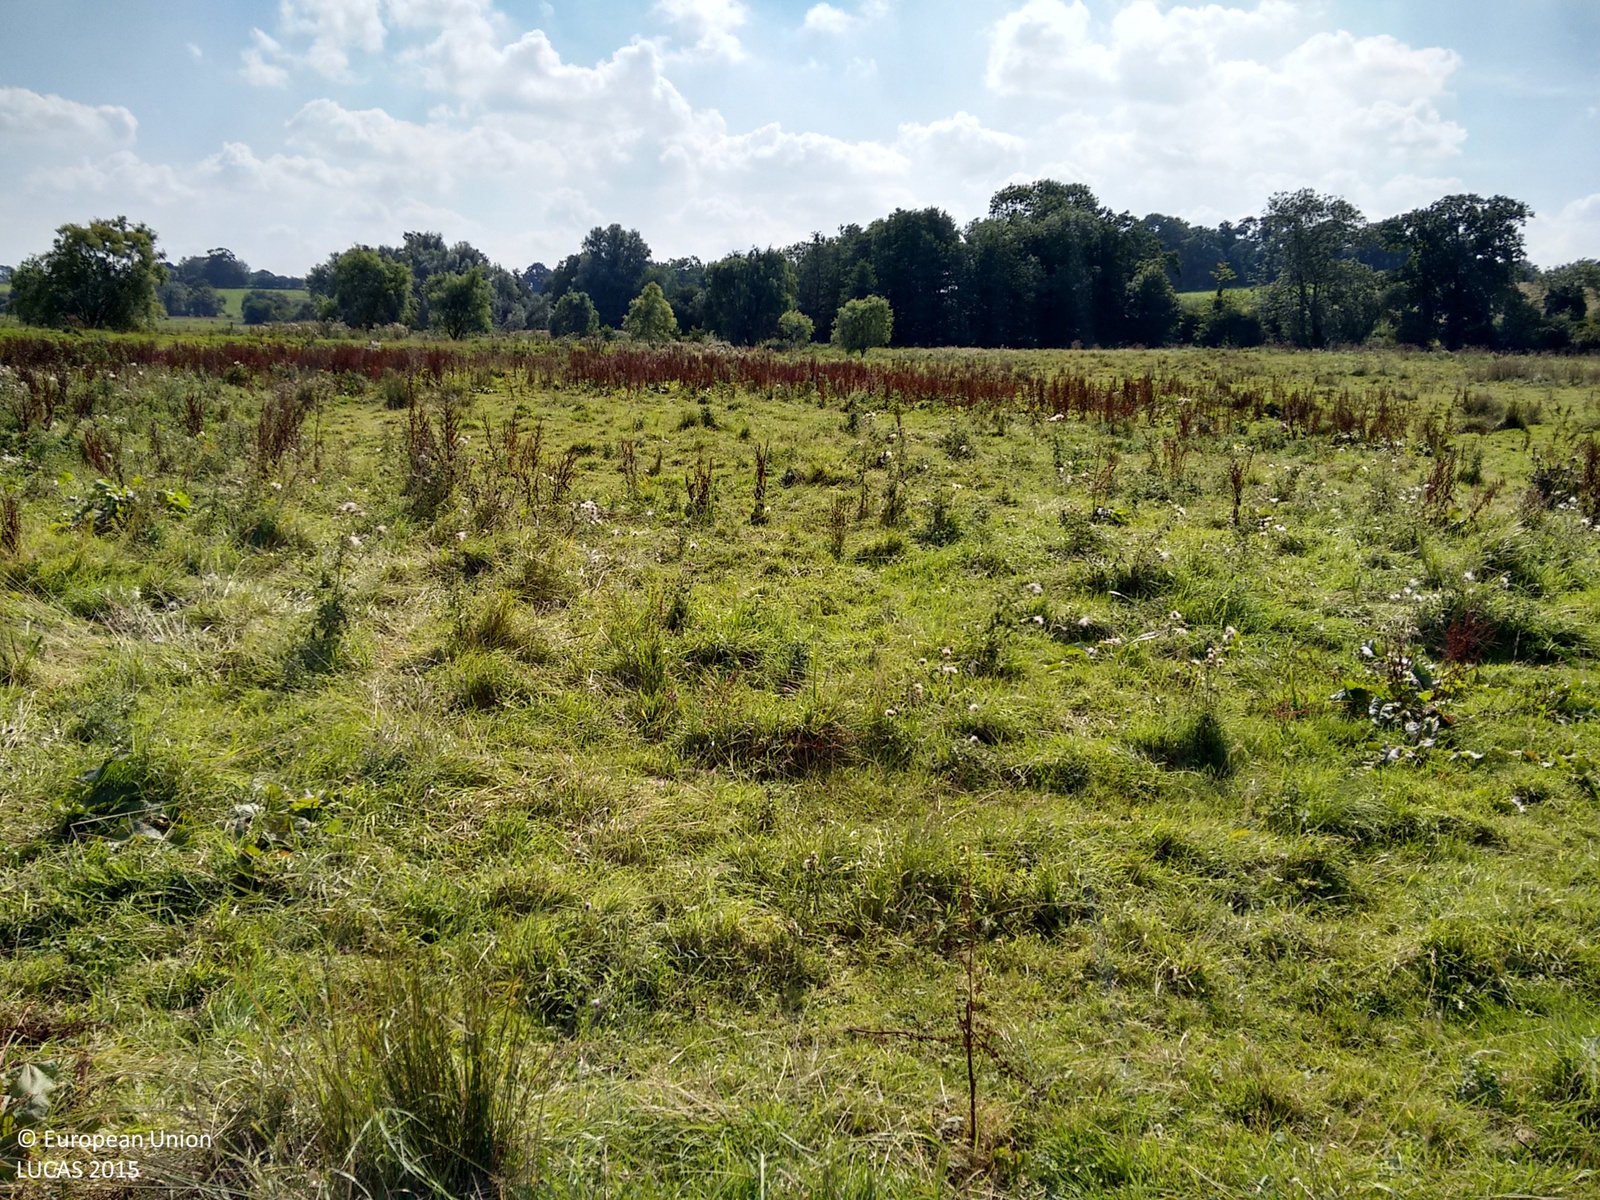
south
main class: Grassland
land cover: Grassland without tree/shrub cover
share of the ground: > 75 %
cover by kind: herbaceous plants 100 %
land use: Agriculture (excluding fallow land and kitchen gardens)
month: September
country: GB
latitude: 52.7218
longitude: 0.9901
